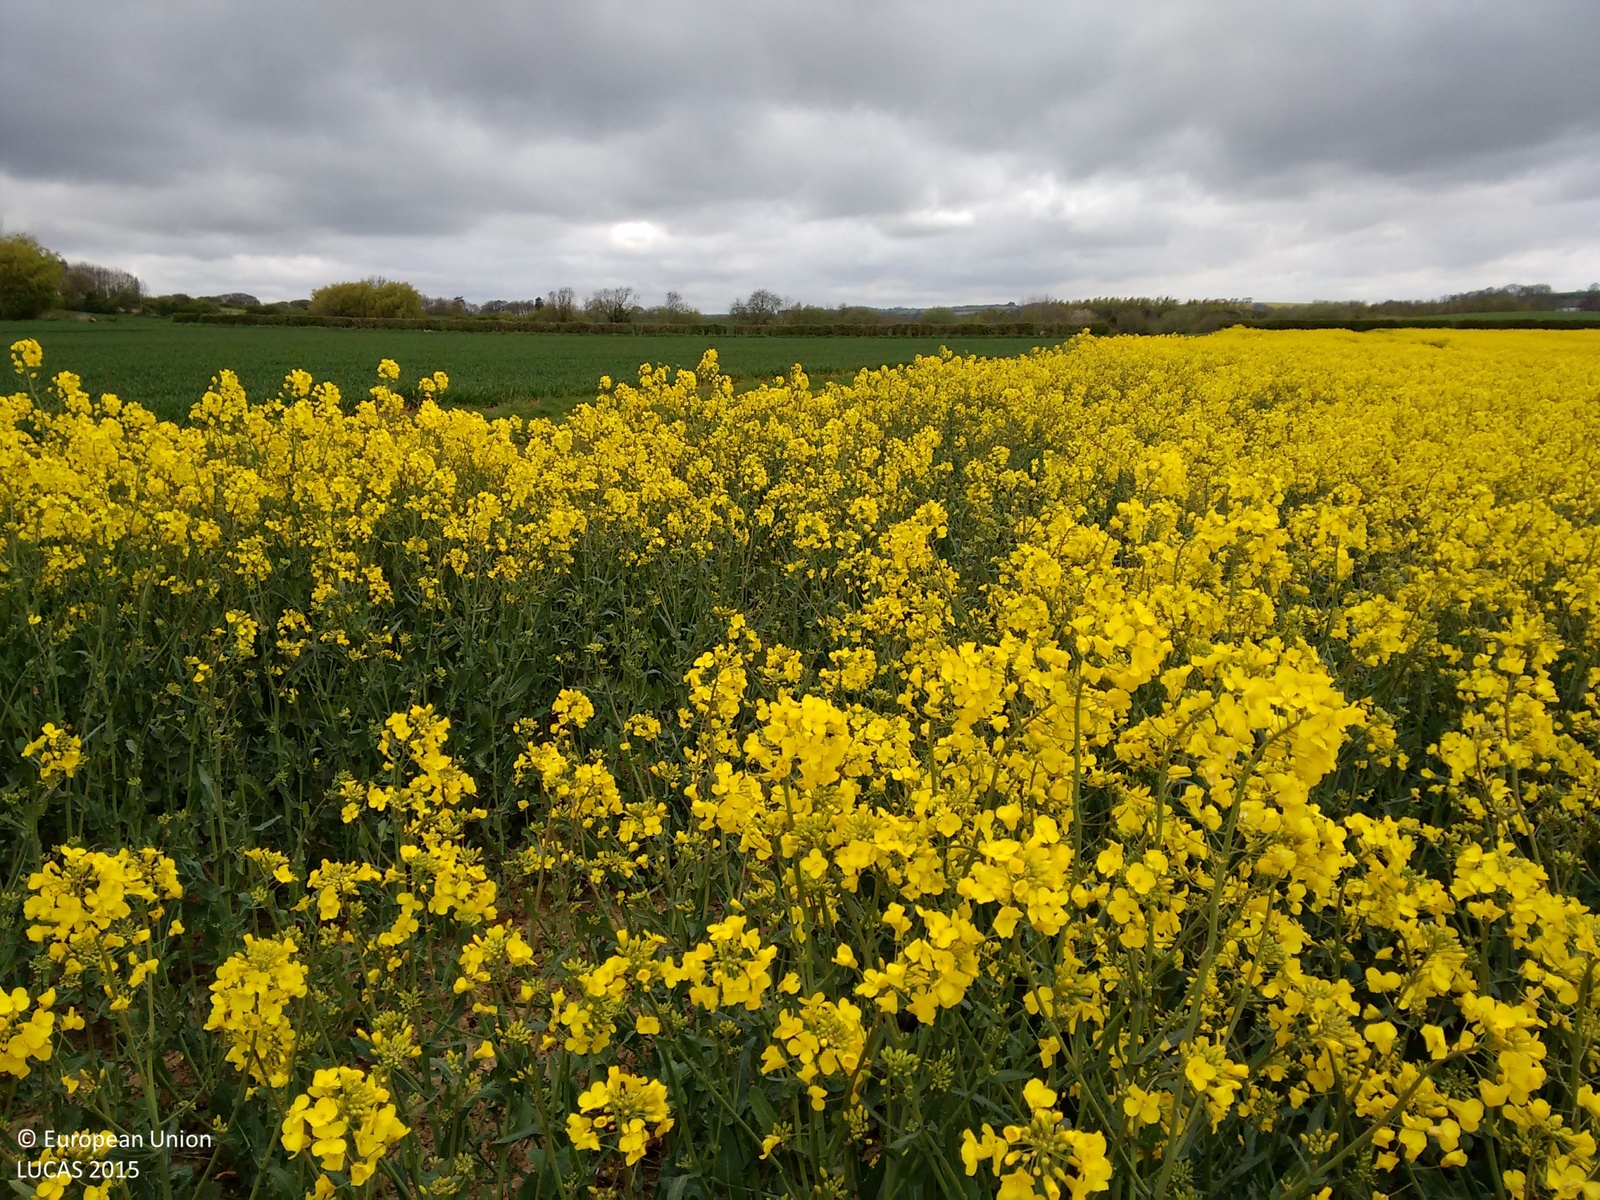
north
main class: Cropland
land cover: Rape and turnip rape
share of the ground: > 75 %
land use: Agriculture (excluding fallow land and kitchen gardens)
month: April
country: GB
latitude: 53.2232
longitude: 0.0077
